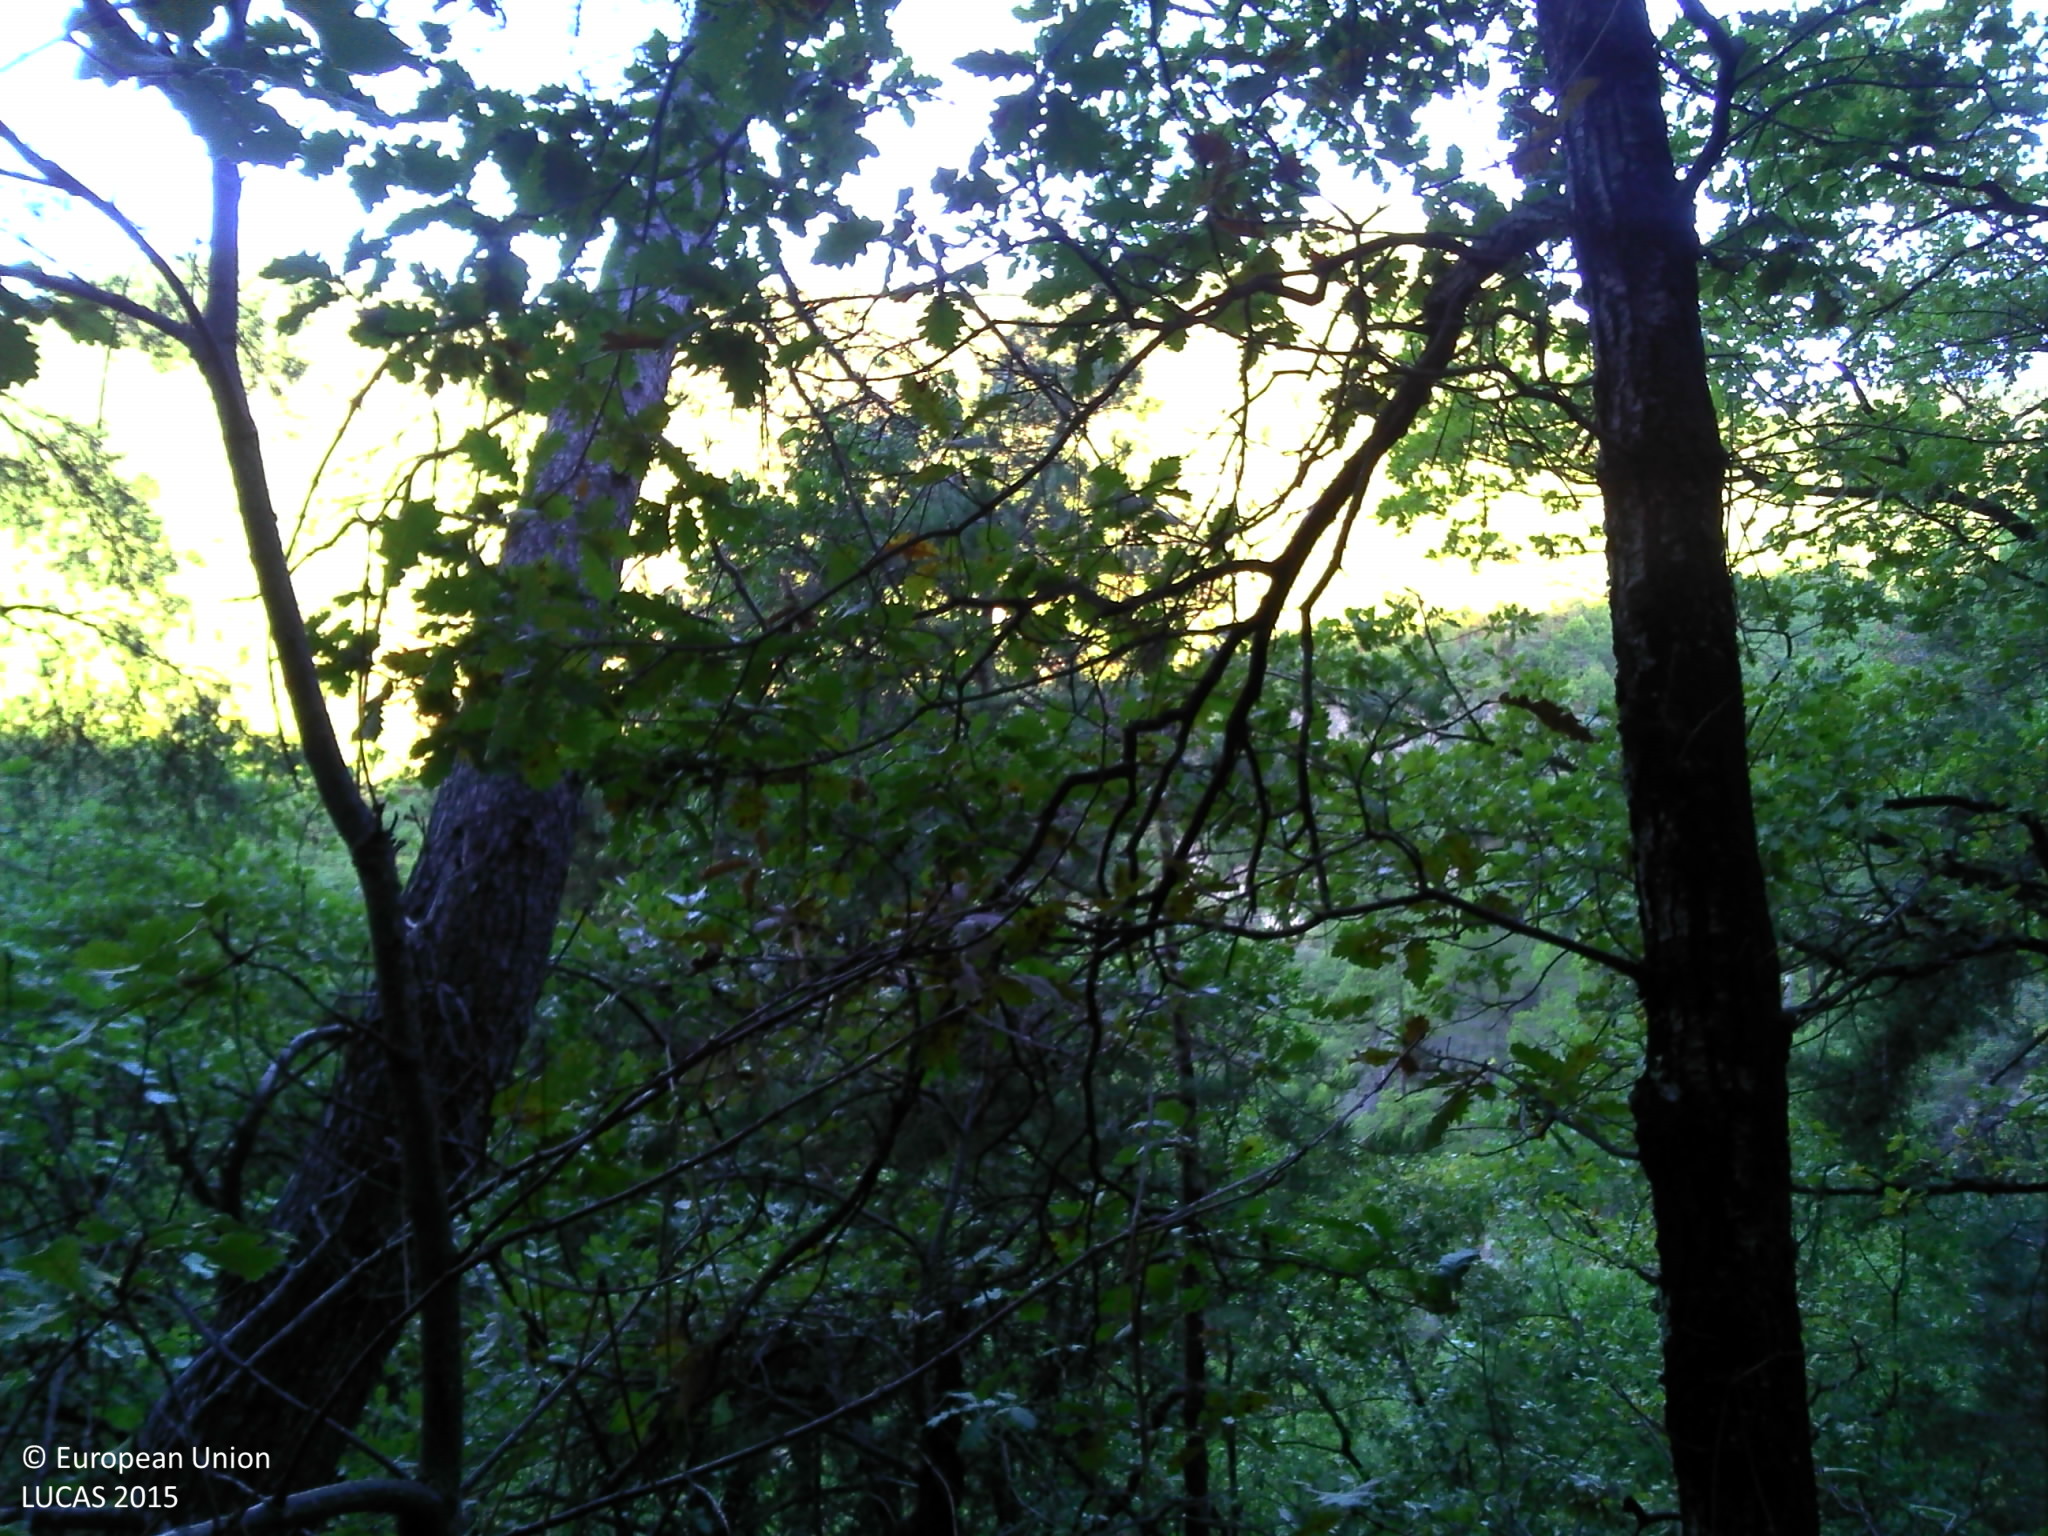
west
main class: Woodland
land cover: Pine dominated mixed woodland
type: coniferous forest of the mediterranean region
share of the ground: 50 - 75 %
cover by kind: coniferous forest trees 40 %, herbaceous plants 30 %, broadleaved forest trees 20 %, shrubs 5 %, lichens and mosses 5 %
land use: Forestry
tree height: > 5 m
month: September
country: FR
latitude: 43.8770
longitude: 7.1070
